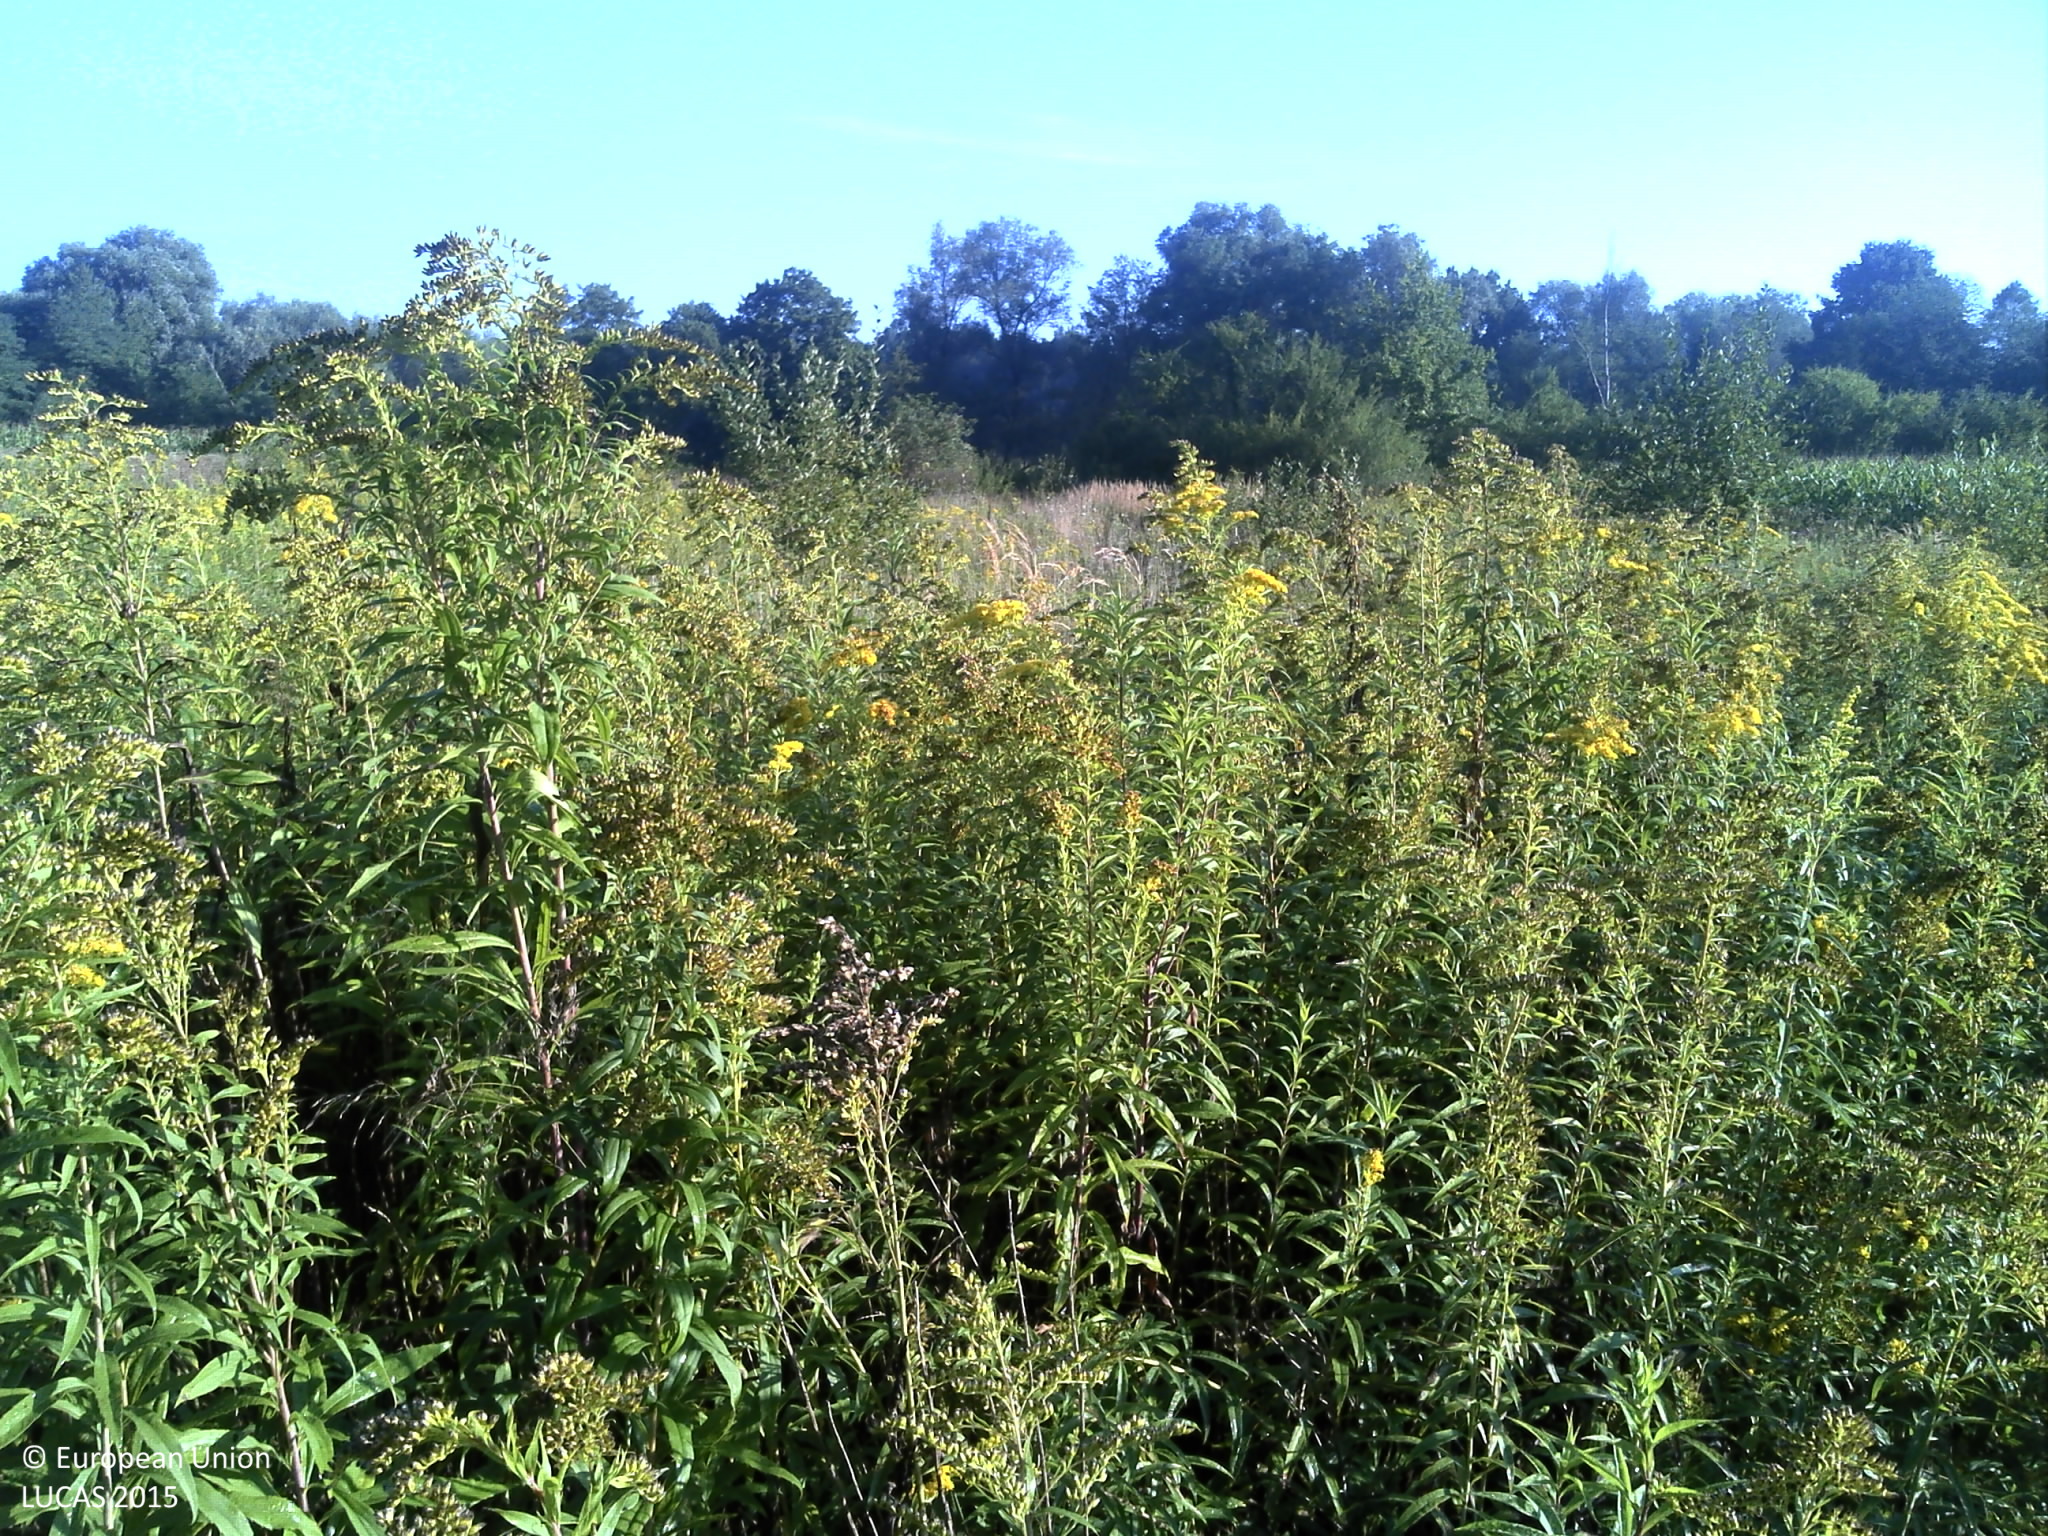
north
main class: Grassland
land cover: Spontaneously vegetated surfaces
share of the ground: > 75 %
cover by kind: herbaceous plants 100 %
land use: Fallow land
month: August
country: HR
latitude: 45.3275
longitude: 16.1082
